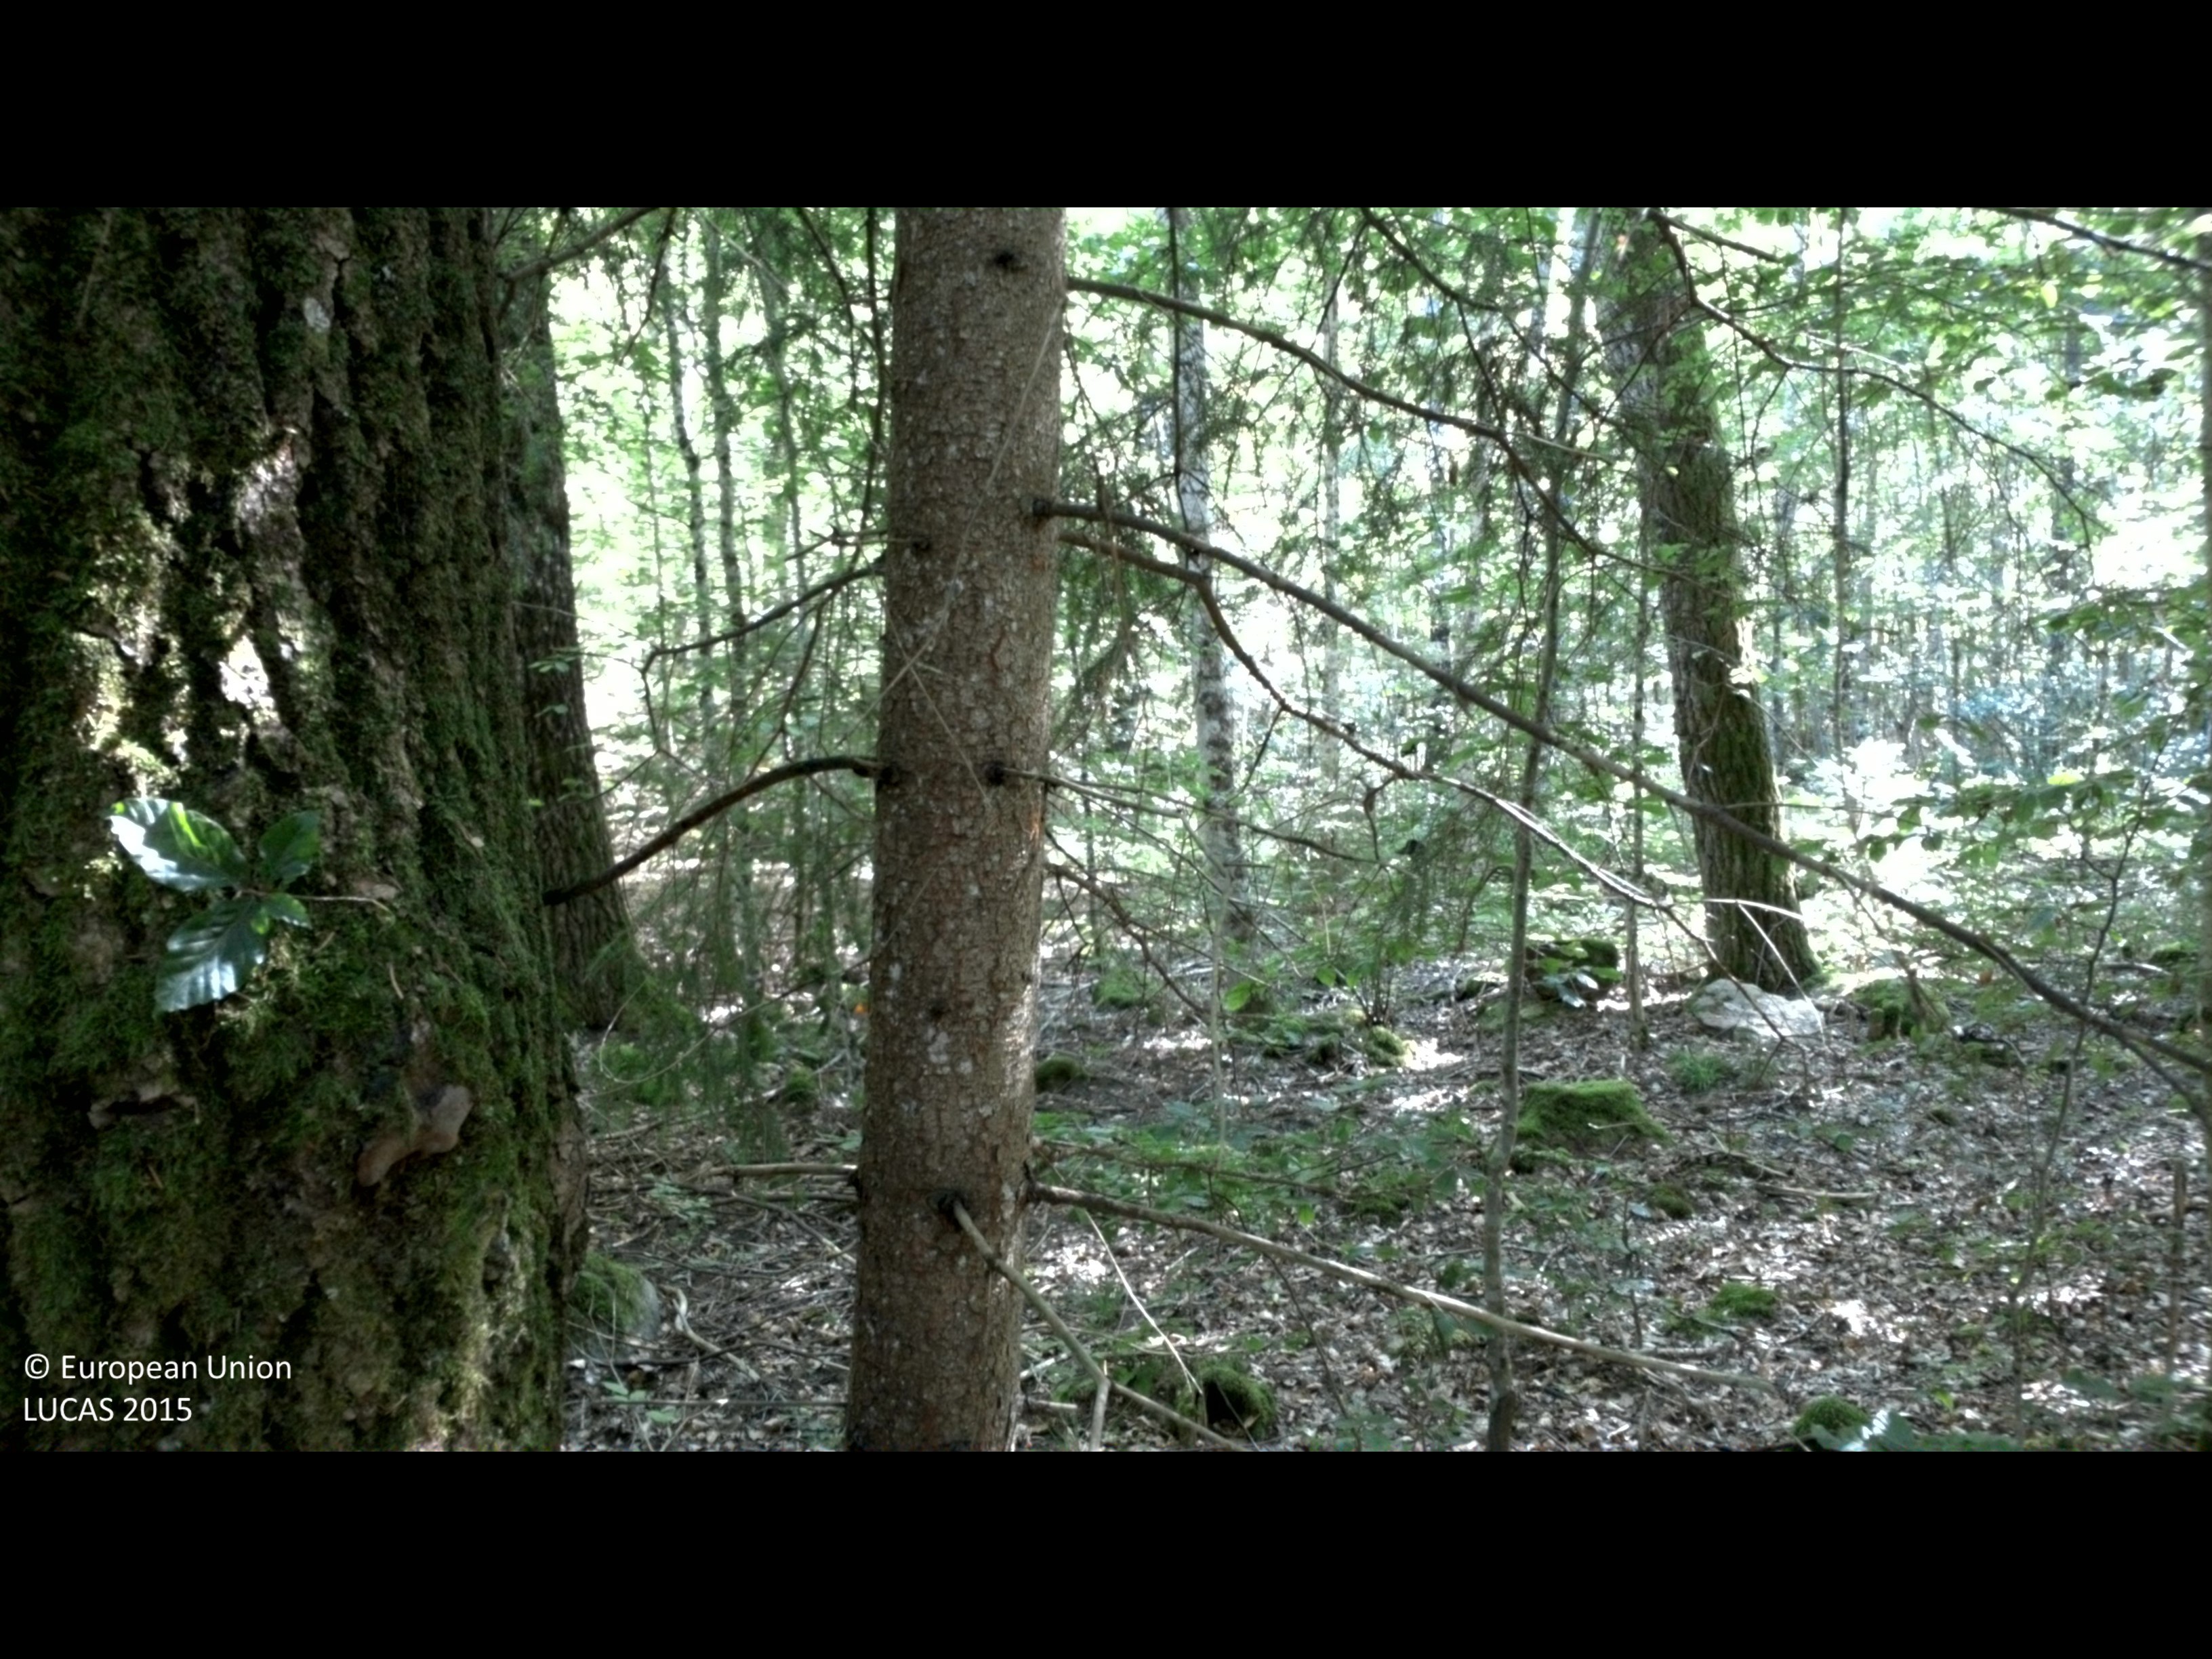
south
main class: Woodland
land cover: Broadleaved woodland
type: beech forest
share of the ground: > 75 %
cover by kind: broadleaved forest trees 75 %, coniferous forest trees 5 %, herbaceous plants 5 %
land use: Forestry
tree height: > 5 m
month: August
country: SE
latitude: 56.2640
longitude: 14.6963
